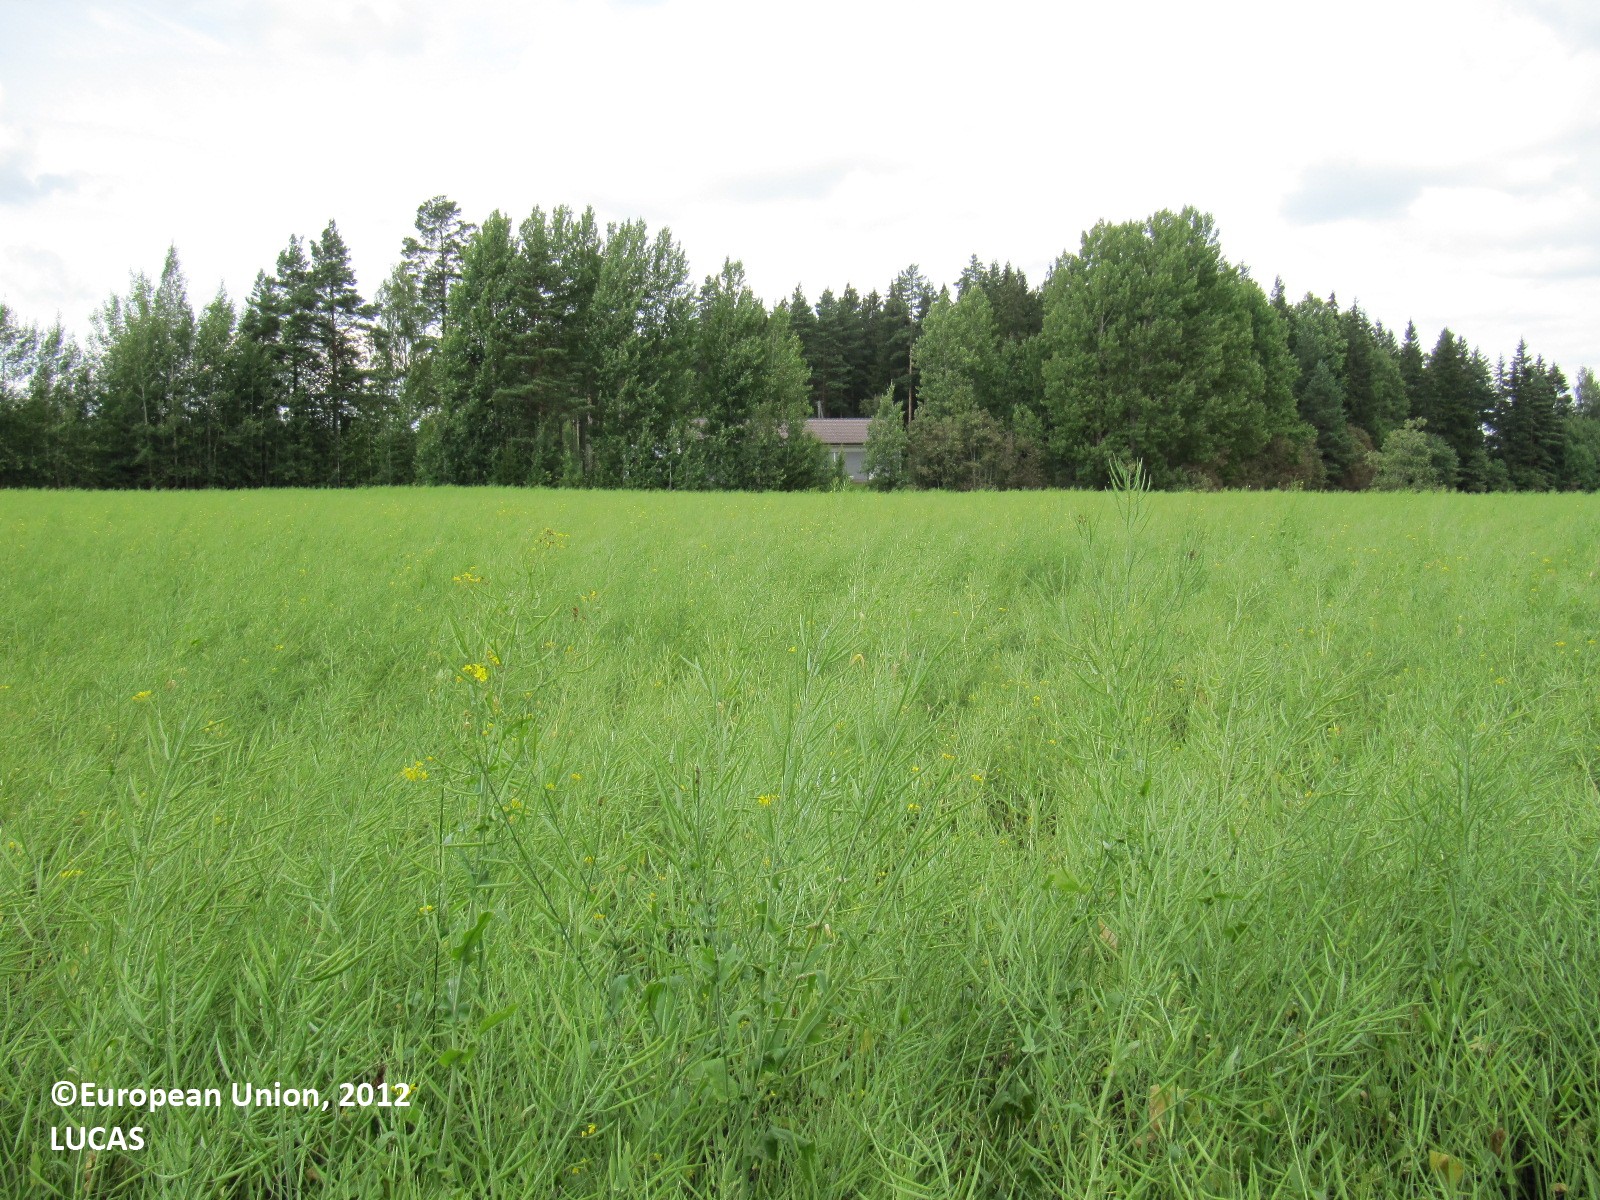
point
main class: Cropland
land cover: Rape and turnip rape
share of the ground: > 75 %
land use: Agriculture (excluding fallow land and kitchen gardens)
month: August
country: FI
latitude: 60.4155
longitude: 23.2106
